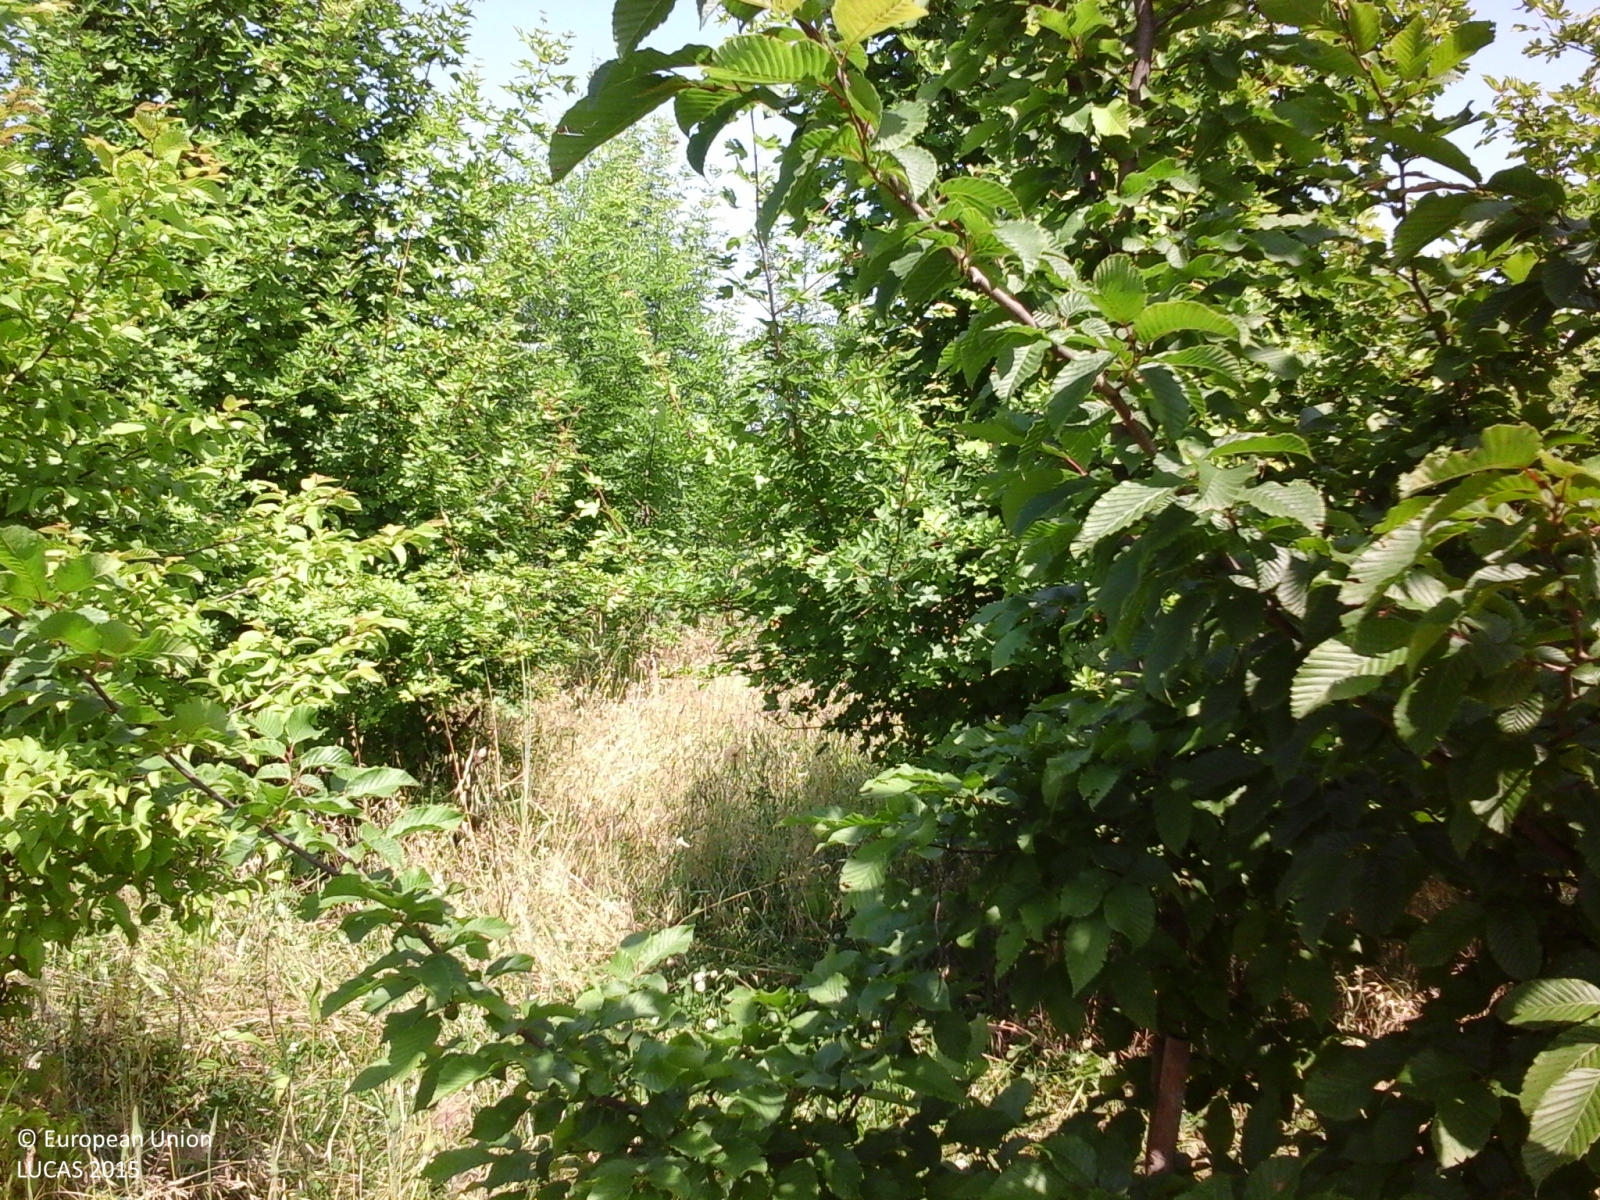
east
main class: Cropland
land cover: Nurseries
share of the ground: 50 - 75 %
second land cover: Spontaneously vegetated surfaces
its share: > 75 %
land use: Agriculture (excluding fallow land and kitchen gardens)
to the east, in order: Nurseries; Spontaneously vegetated surfaces; Grassland without tree/shrub cover; Ditches and canals; Grassland without tree/shrub cover; Managed hedges; Grassland without tree/shrub cover; Inland fresh running water; Grassland without tree/shrub cover; Sunflower; Grassland without tree/shrub cover; Single bushes/trees; Paved roads, cycling and walking lanes; Grassland without tree/shrub cover; Paved roads, cycling and walking lanes
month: June
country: IT
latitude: 44.5060
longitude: 11.1923
